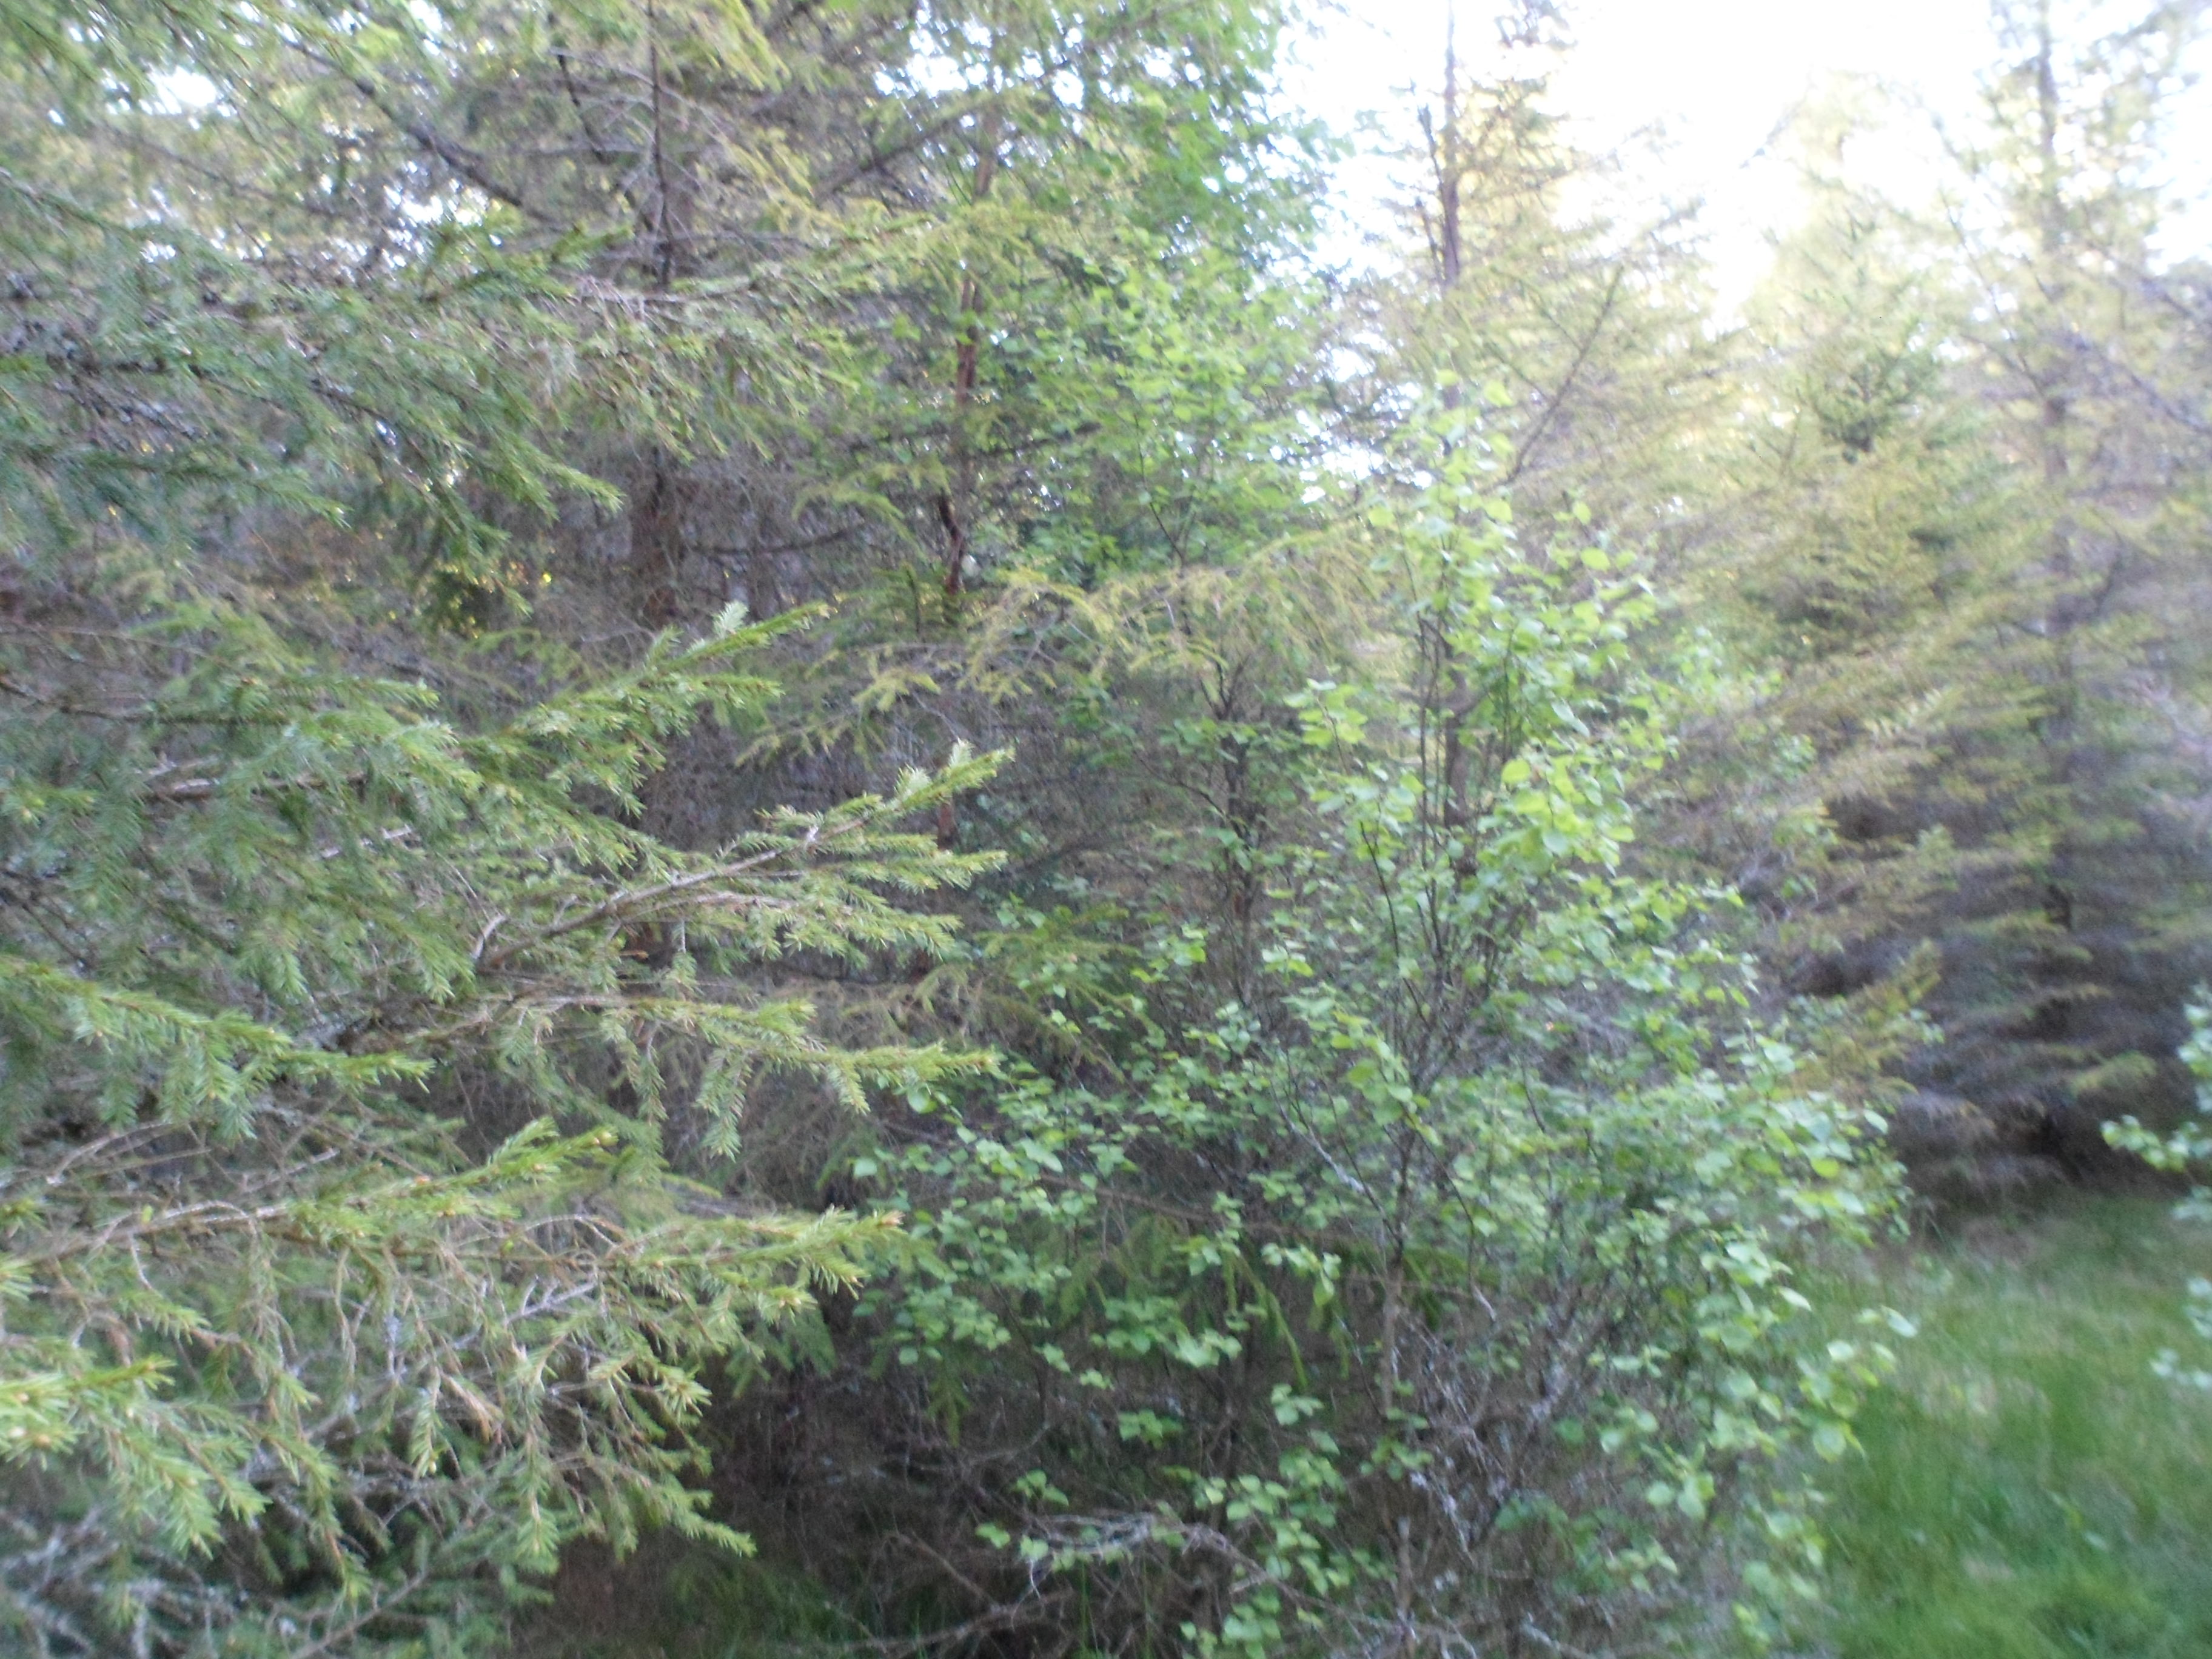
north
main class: Woodland
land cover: Spruce dominated coniferous woodland
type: boreal forest
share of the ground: > 75 %
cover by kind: coniferous forest trees 75 %, broadleaved forest trees 10 %, herbaceous plants 10 %, lichens and mosses 5 %
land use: Forestry
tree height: > 5 m
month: June
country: SE
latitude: 57.3445
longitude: 14.1666
